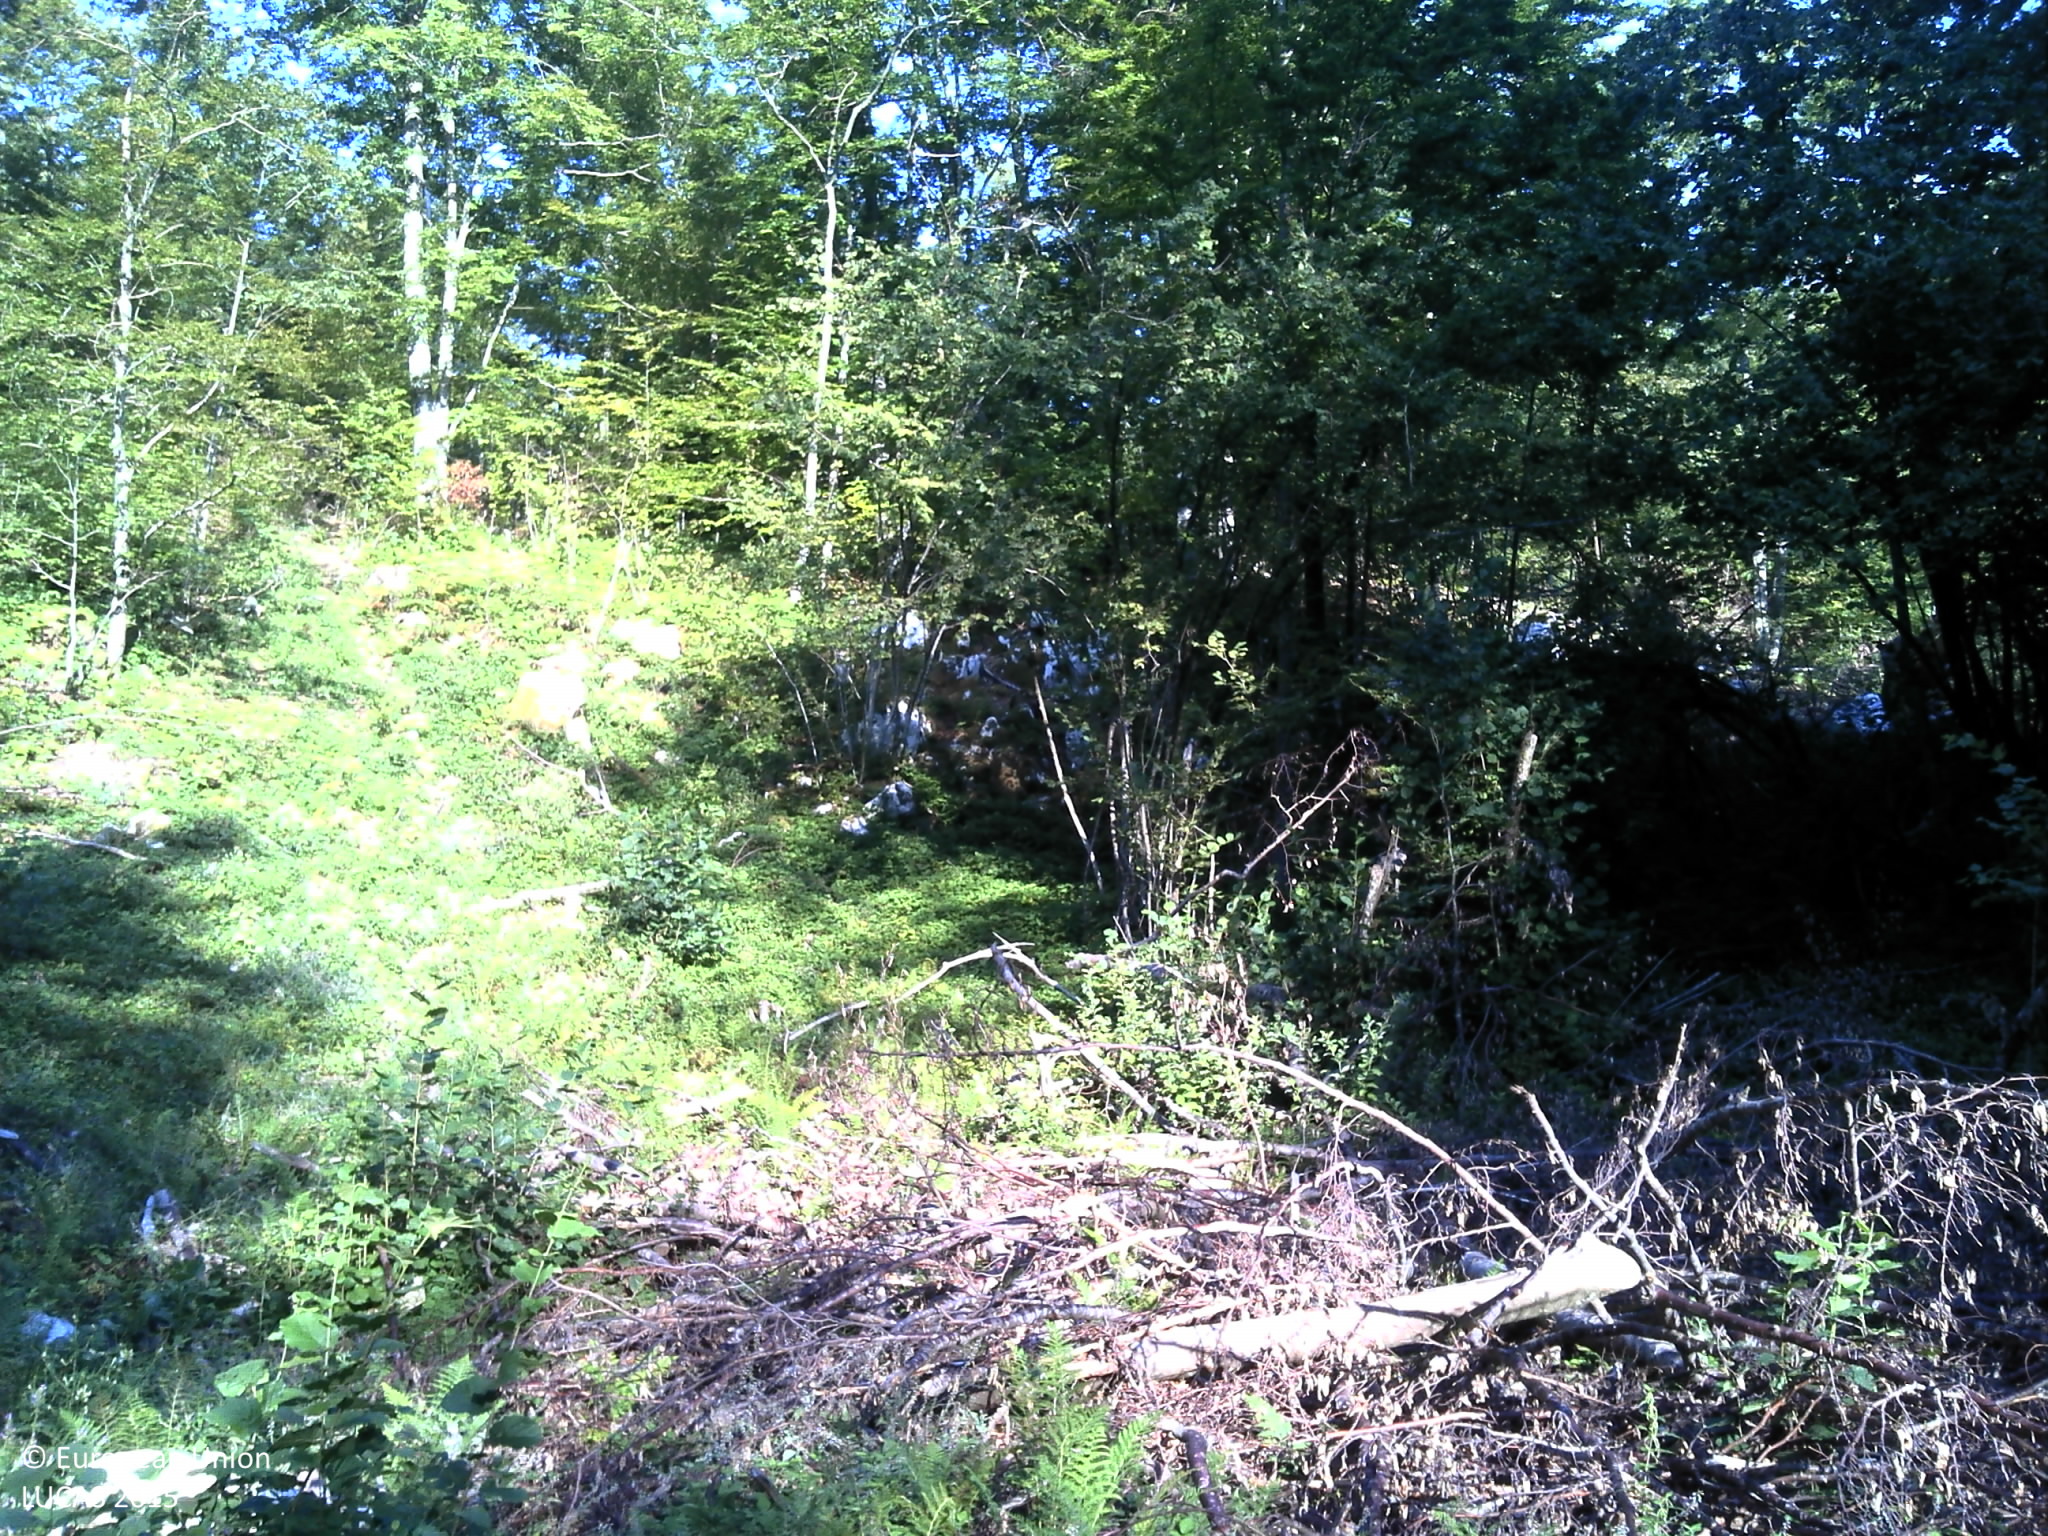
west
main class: Grassland
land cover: Spontaneously vegetated surfaces
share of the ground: > 75 %
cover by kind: herbaceous plants 100 %
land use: Forestry
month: September
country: HR
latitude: 45.1671
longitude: 15.0458
